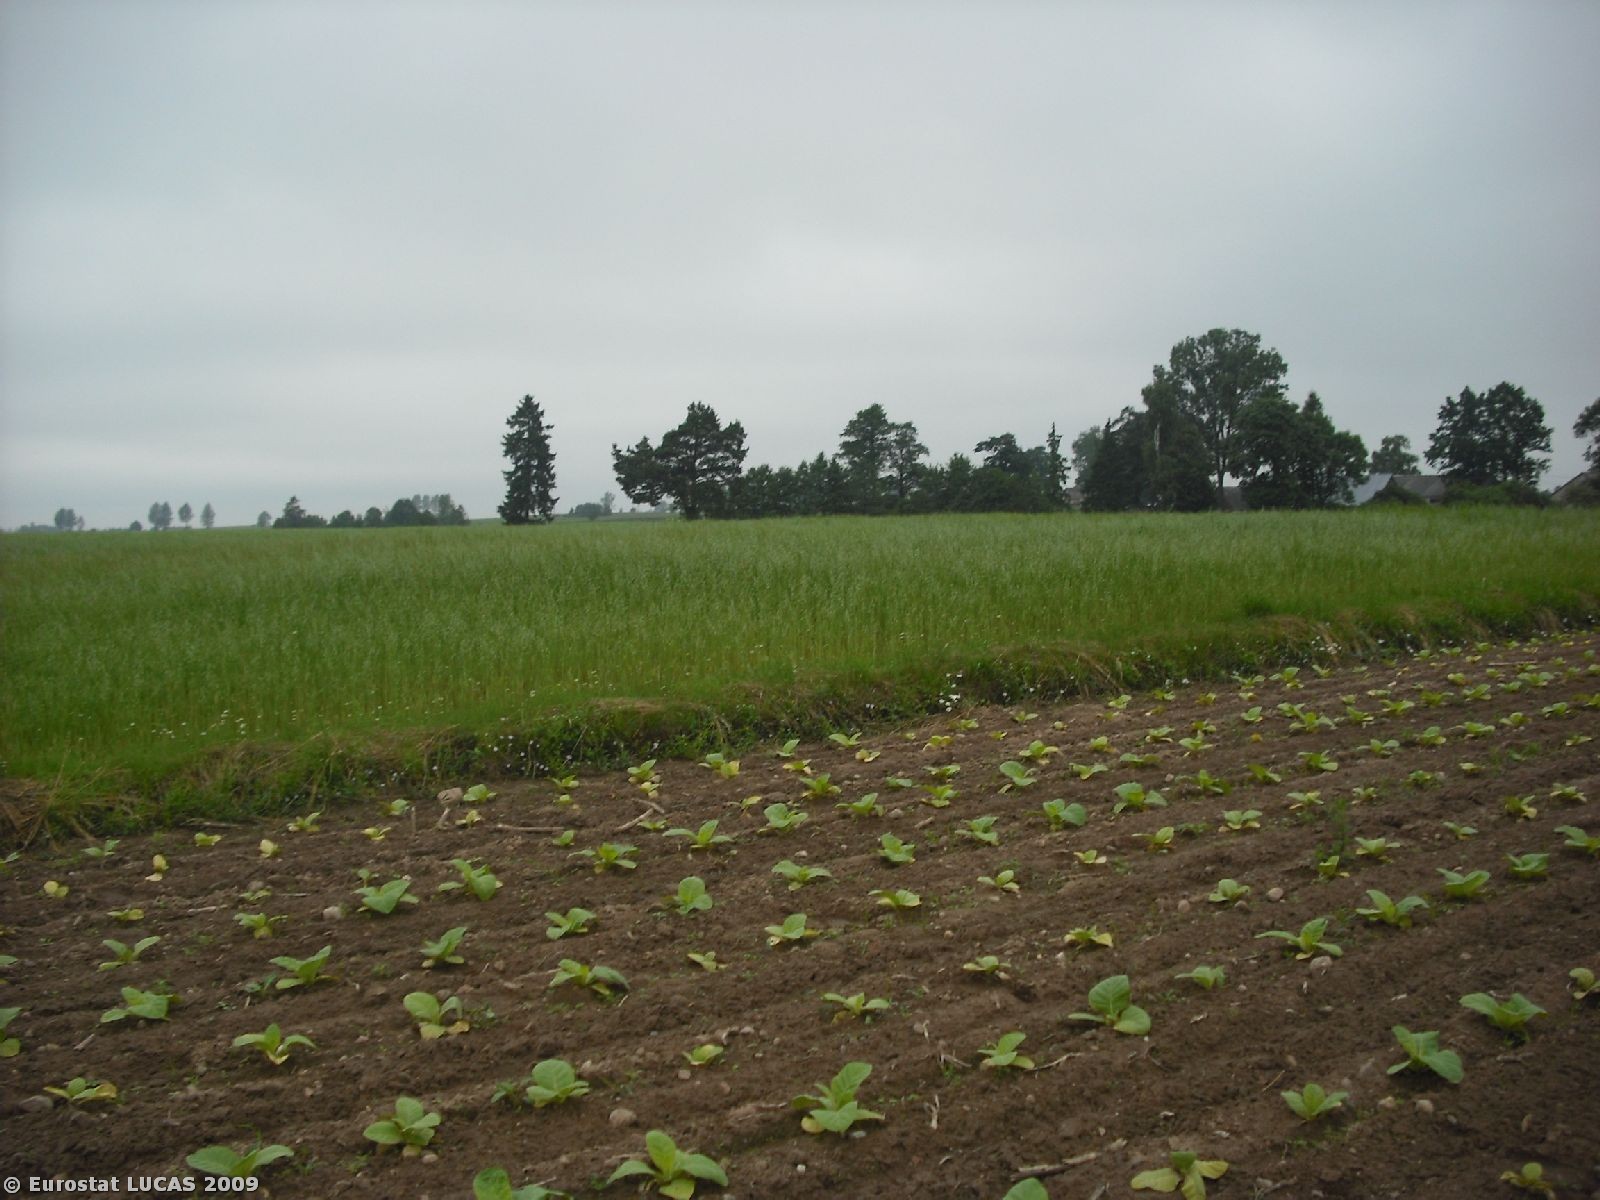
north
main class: Cropland
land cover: Tobacco
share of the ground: 25 - 50 %
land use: Agriculture (excluding fallow land and kitchen gardens)
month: June
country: PL
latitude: 53.9791
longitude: 22.7710
